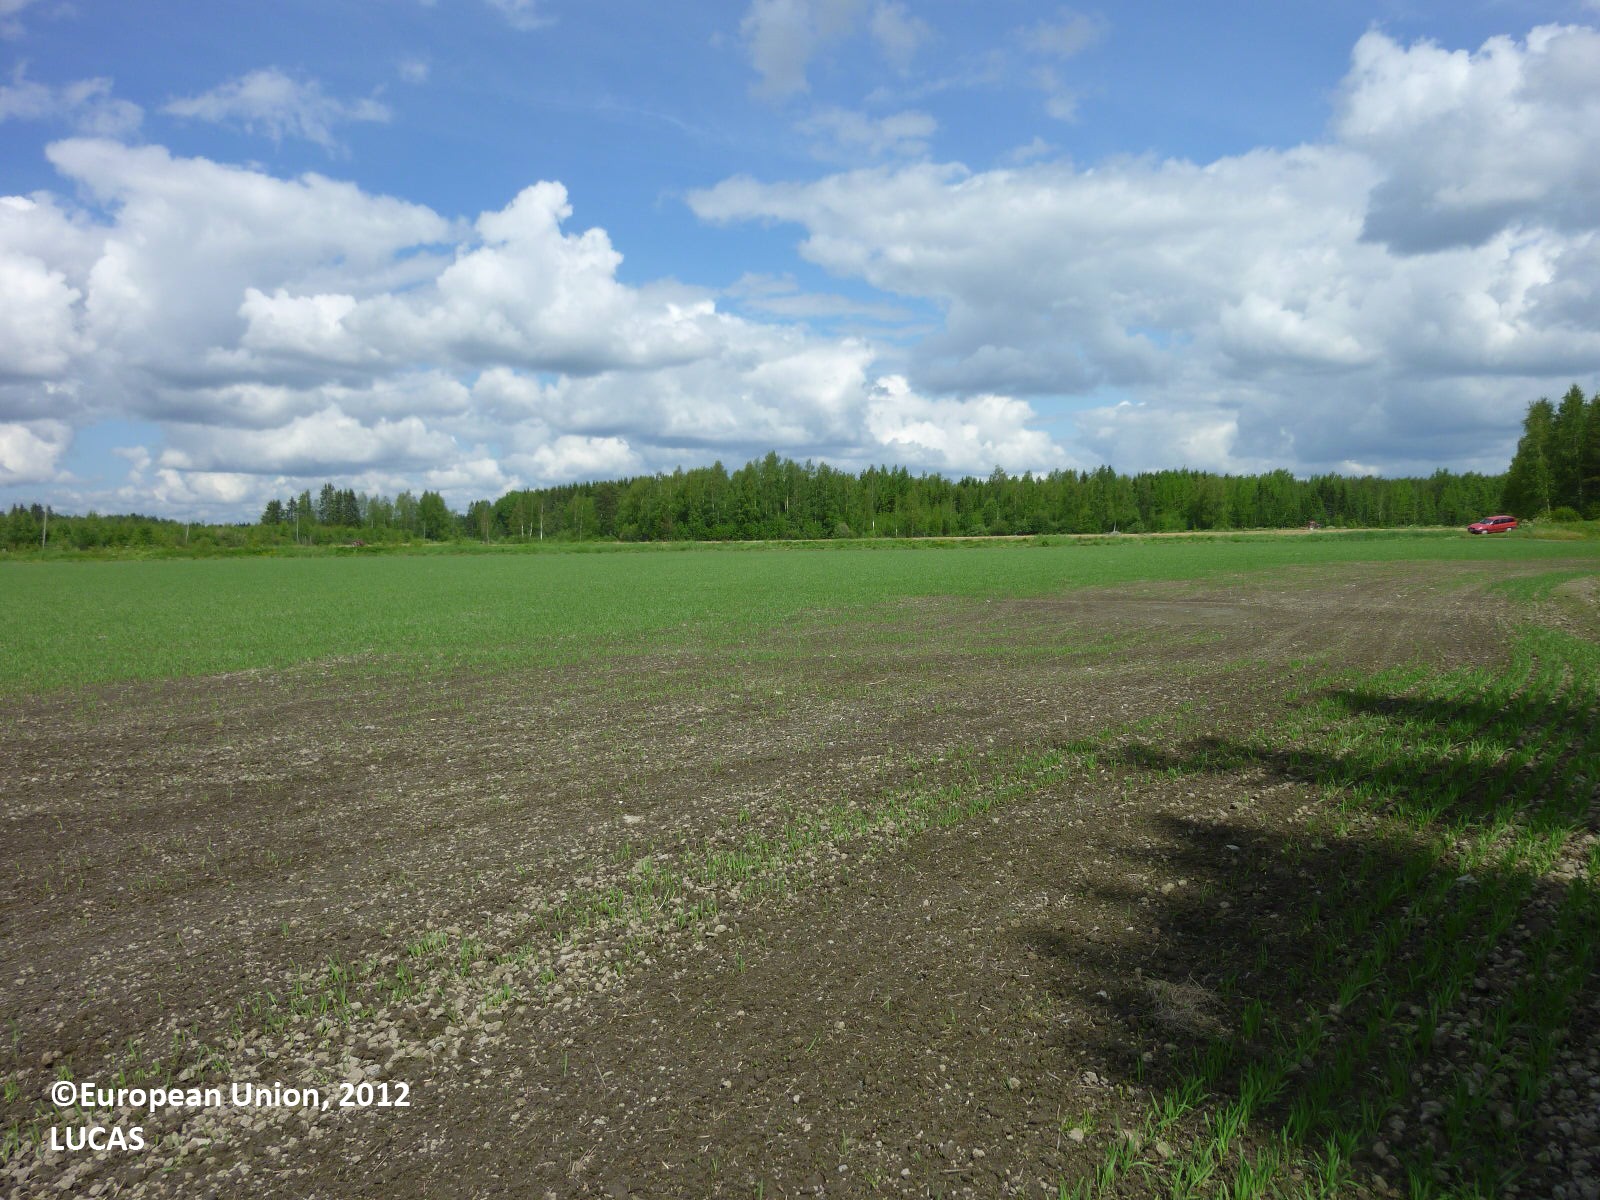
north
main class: Cropland
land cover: Oats
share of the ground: 25 - 50 %
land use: Agriculture (excluding fallow land and kitchen gardens)
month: June
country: FI
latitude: 61.3928
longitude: 22.5148
